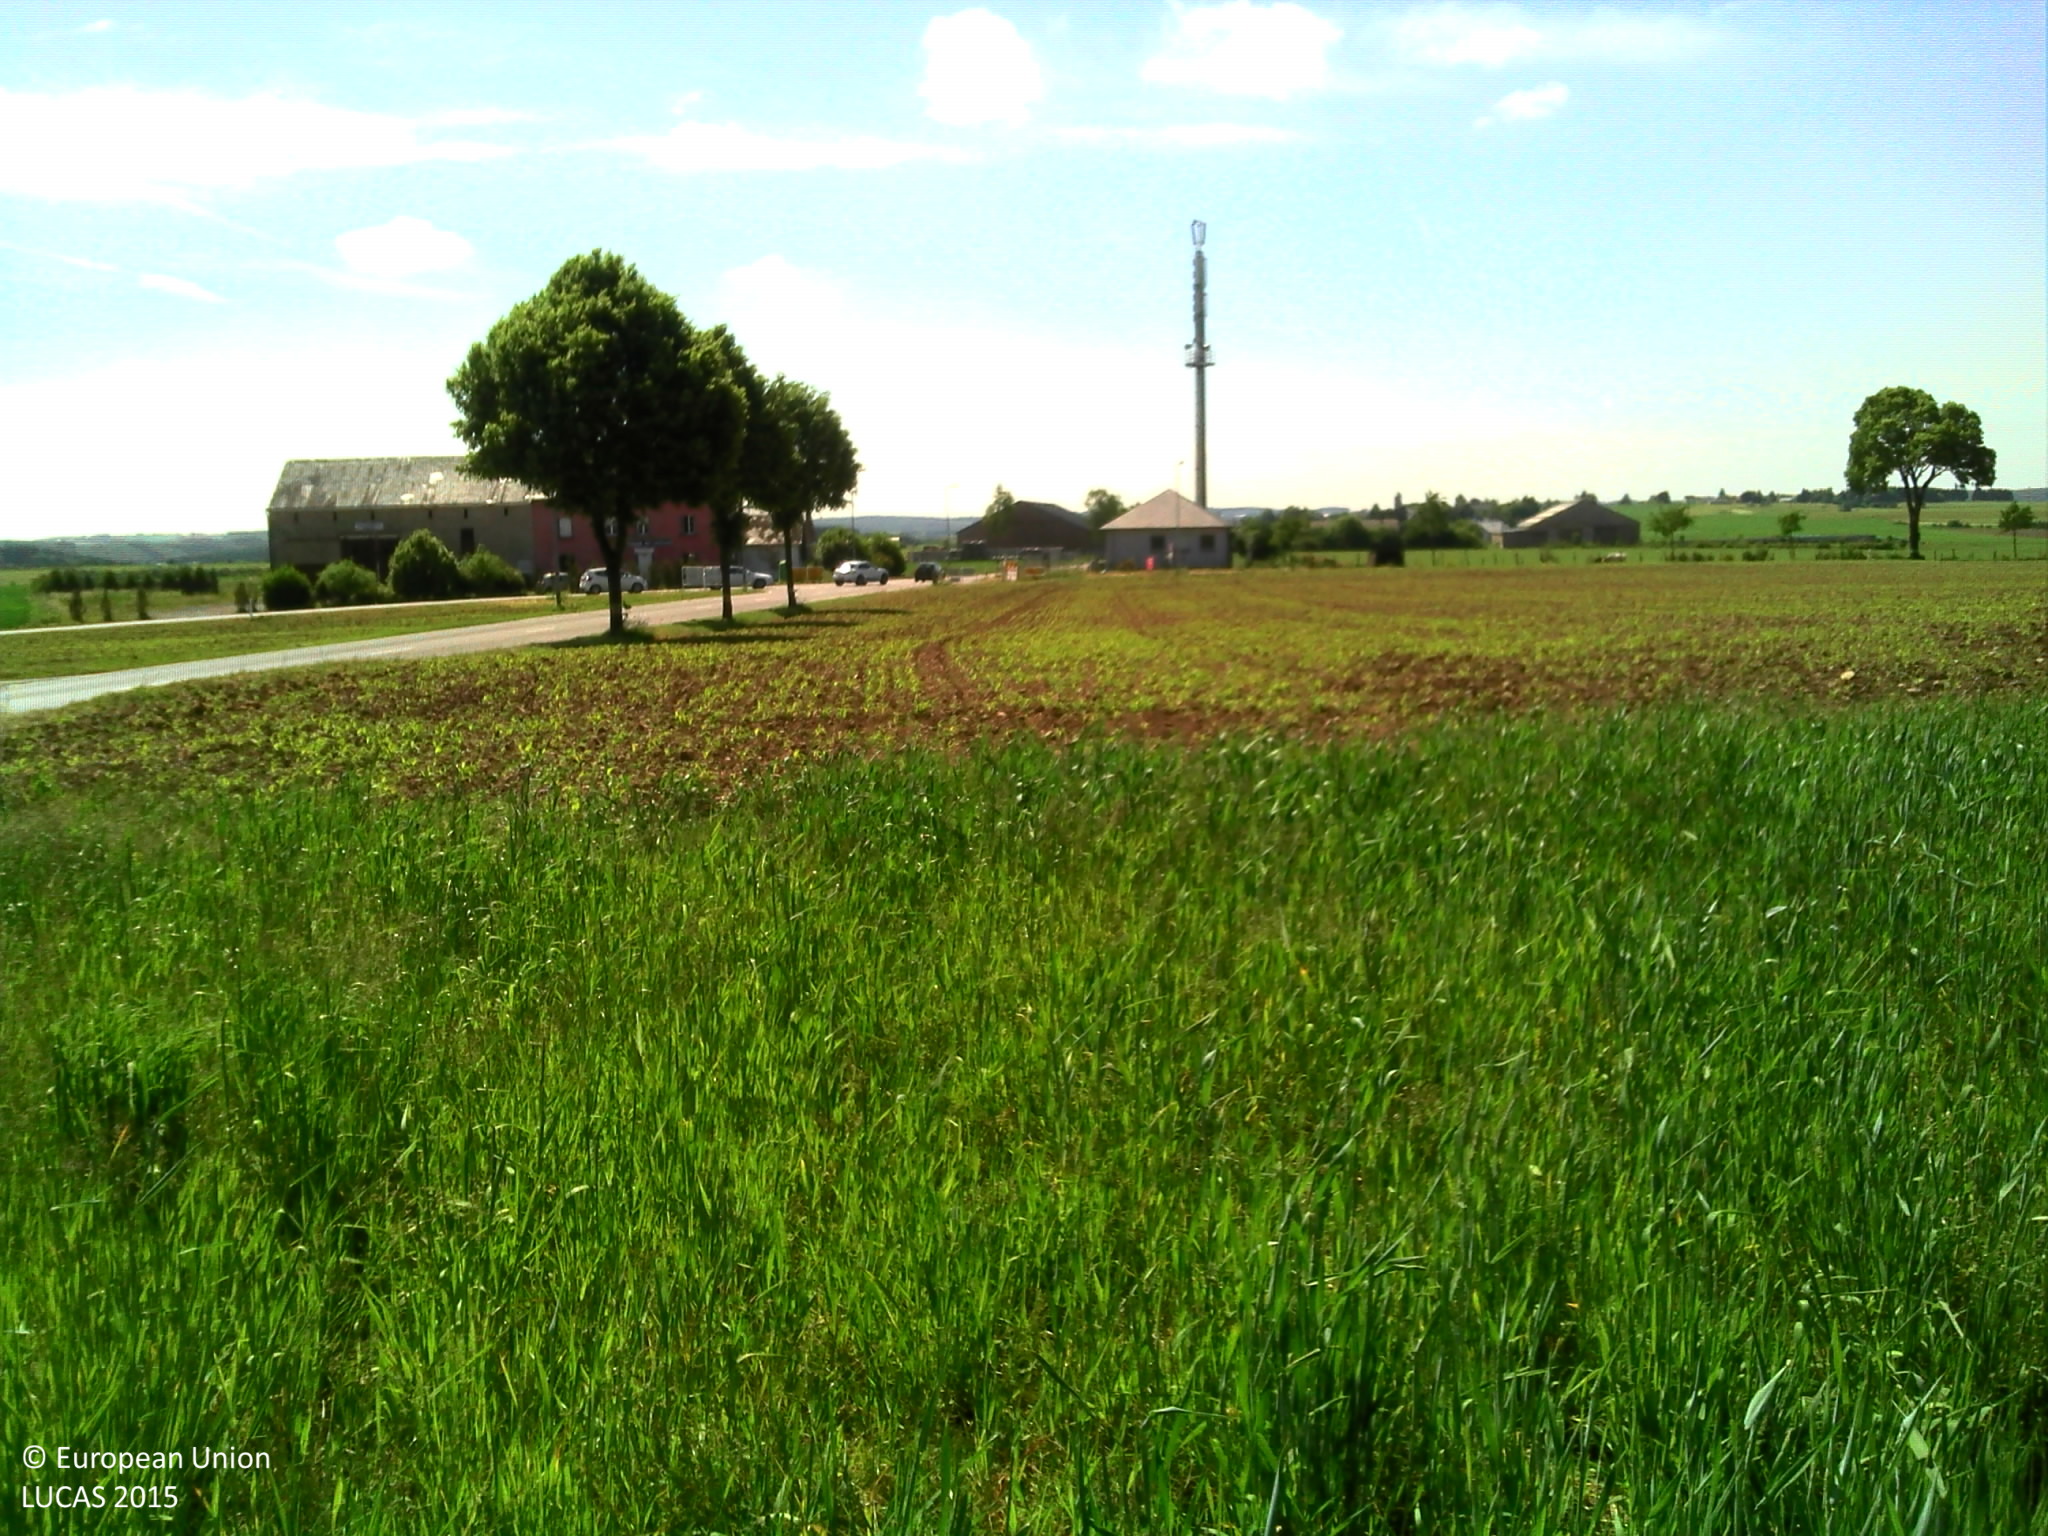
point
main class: Cropland
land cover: Common wheat
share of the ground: > 75 %
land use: Agriculture (excluding fallow land and kitchen gardens)
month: June
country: LU
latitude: 49.9091
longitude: 5.8075
